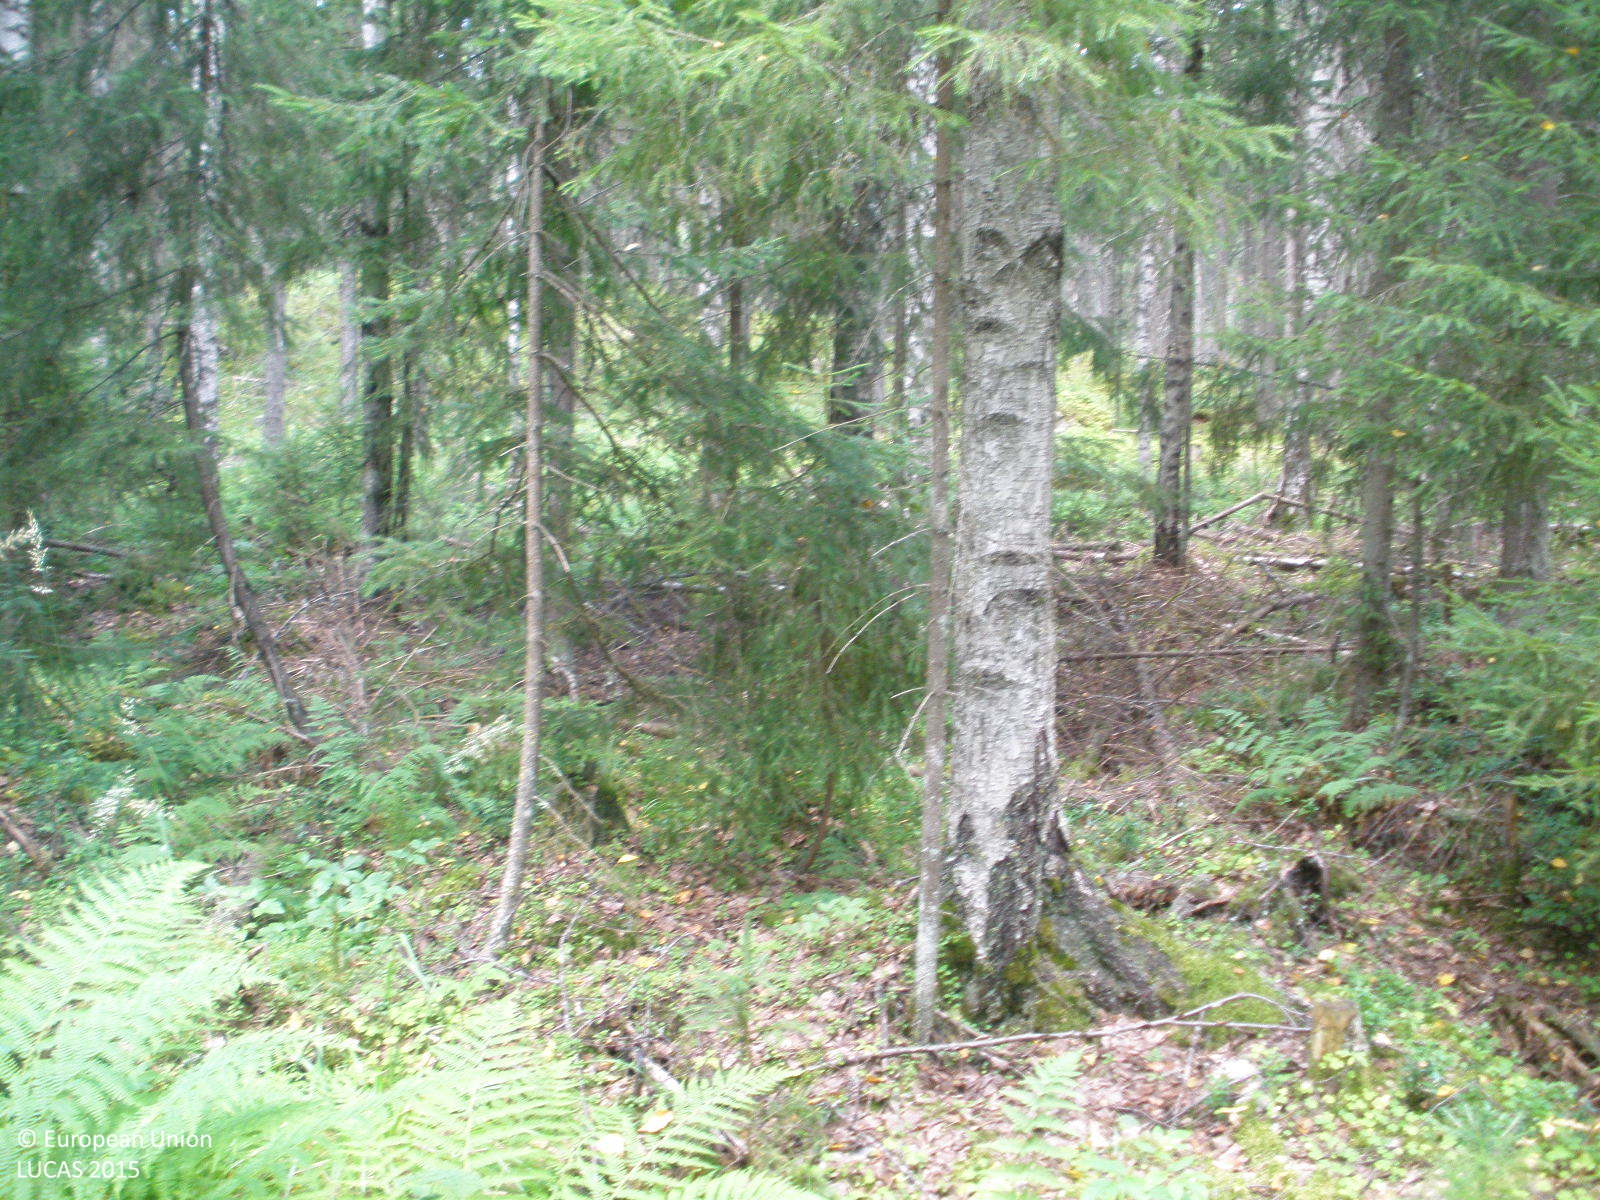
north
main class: Woodland
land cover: Spruce dominated mixed woodland
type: boreal forest
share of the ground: > 75 %
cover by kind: broadleaved forest trees 55 %, coniferous forest trees 30 %, herbaceous plants 10 %, lichens and mosses 5 %
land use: Forestry
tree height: > 5 m
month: August
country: FI
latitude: 61.0027
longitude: 24.6973
